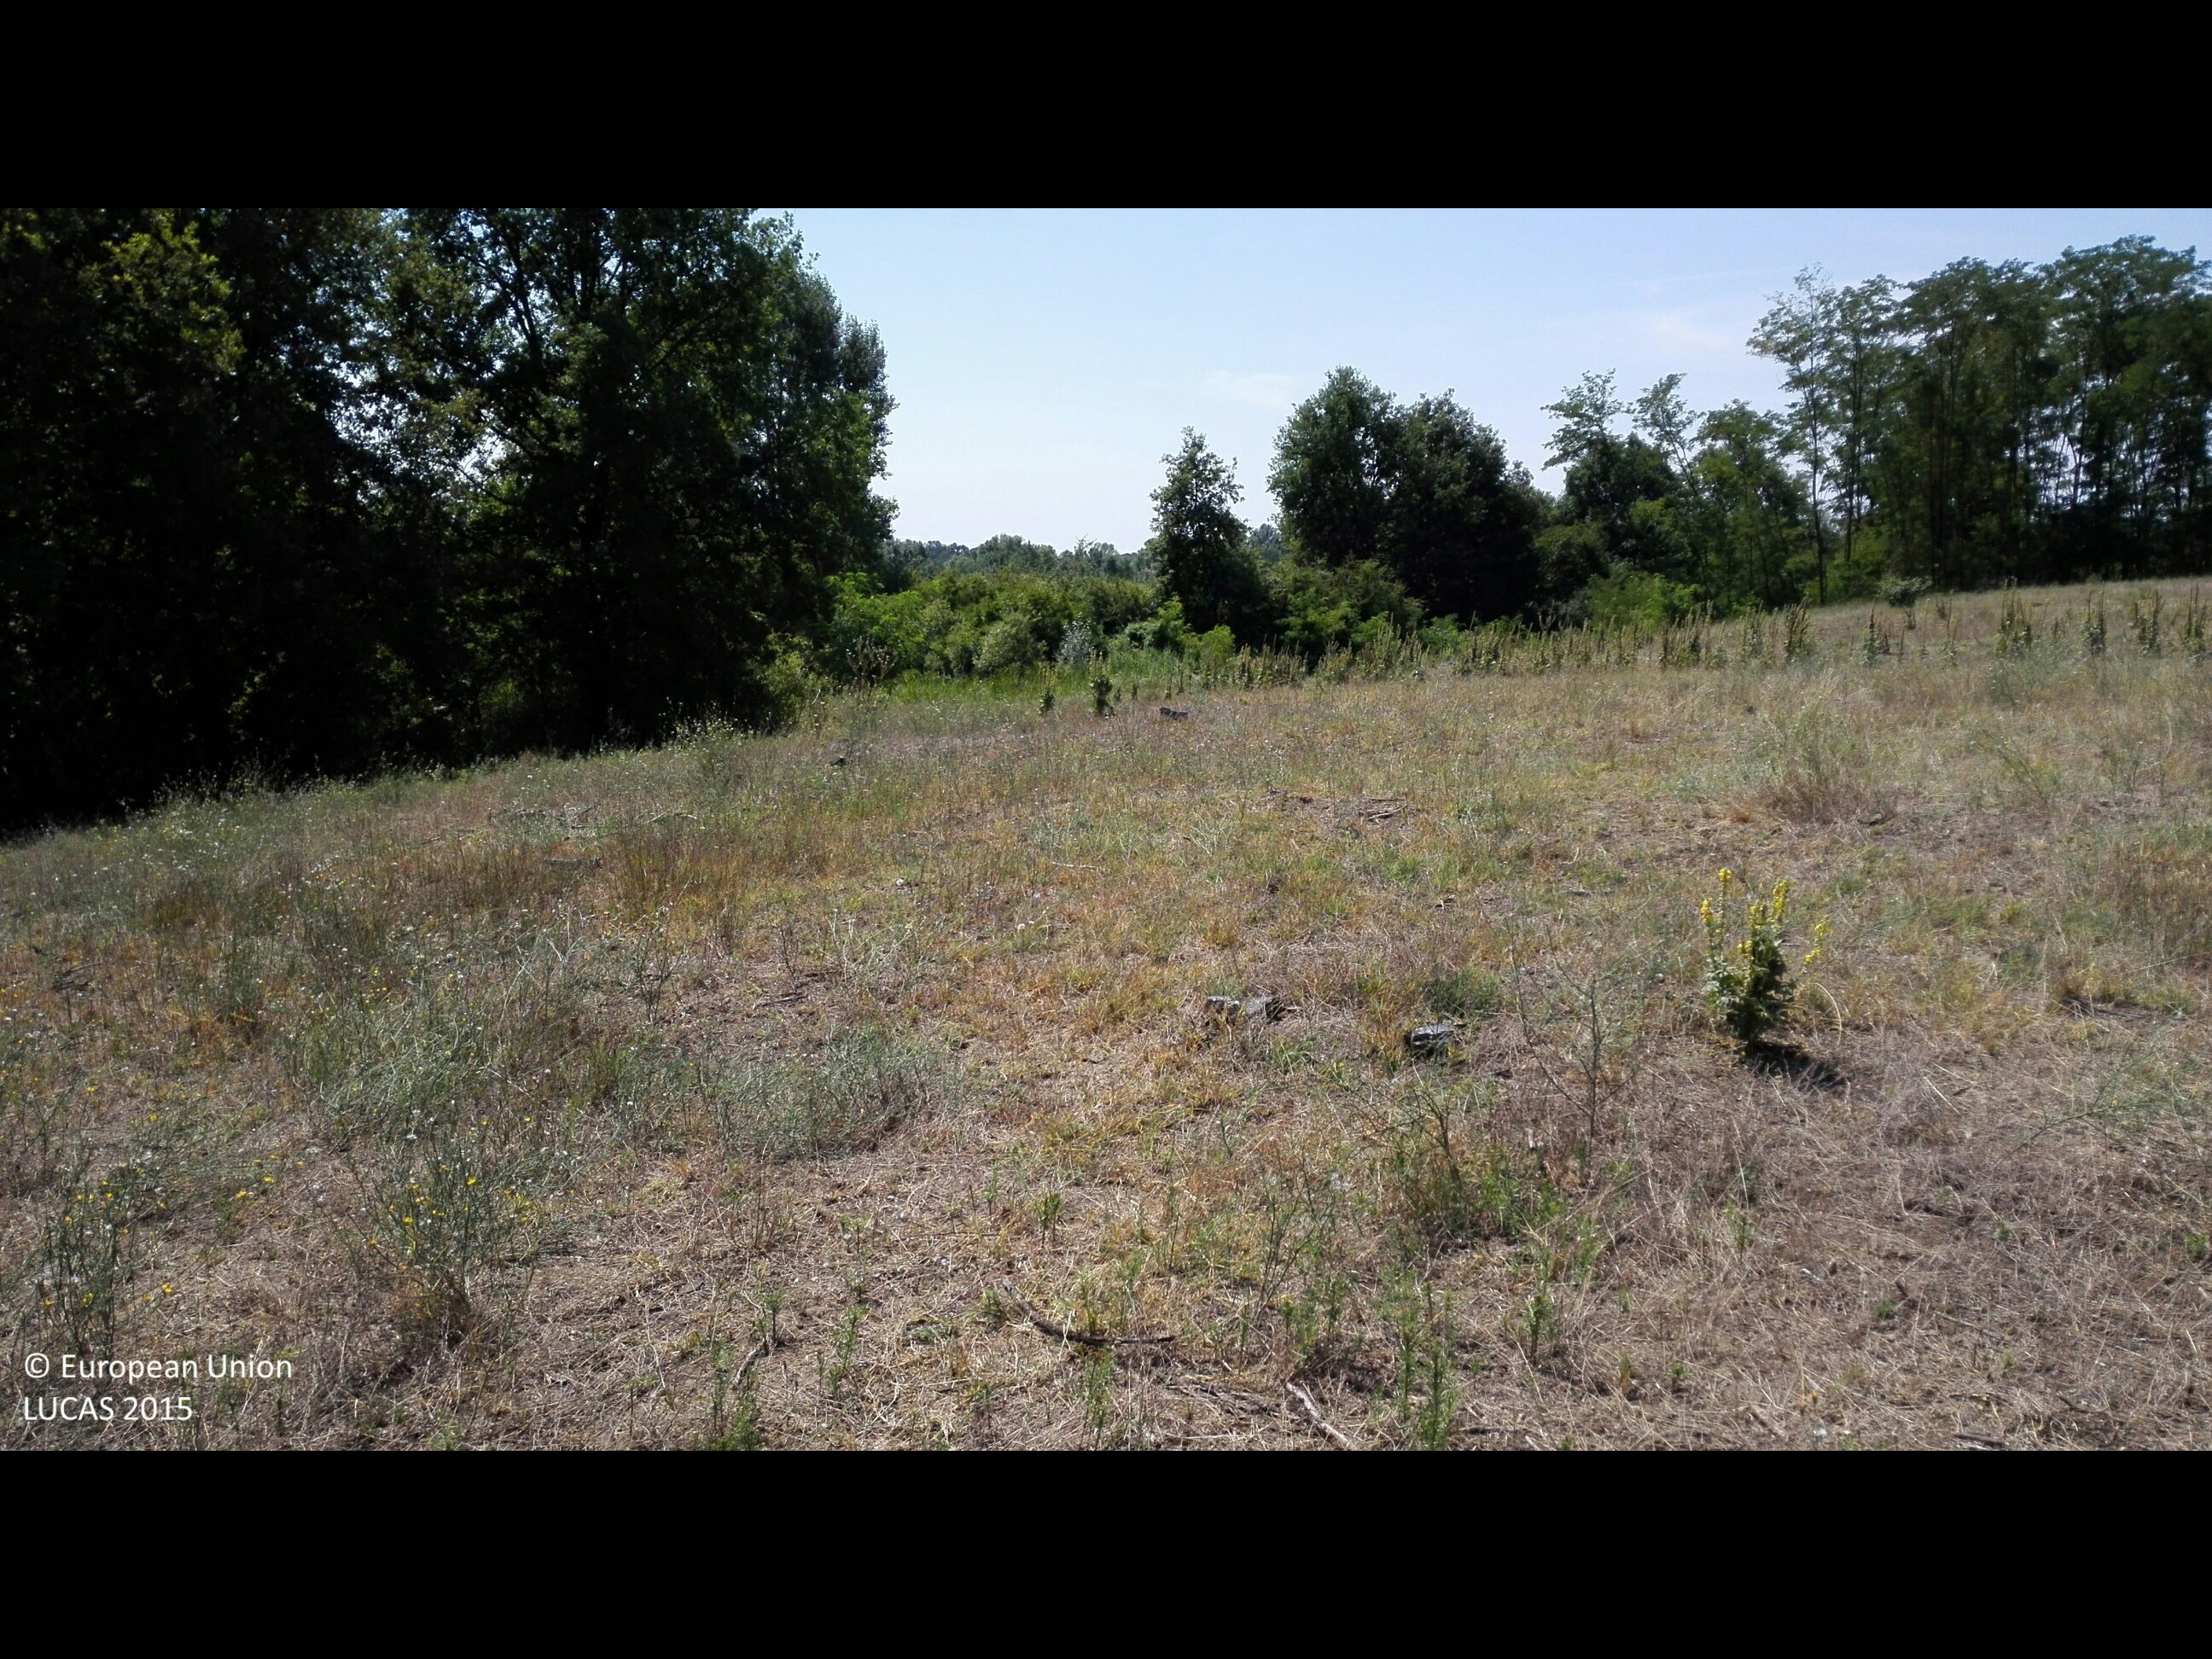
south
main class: Grassland
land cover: Grassland without tree/shrub cover
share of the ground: > 75 %
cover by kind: herbaceous plants 100 %
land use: Agriculture (excluding fallow land and kitchen gardens)
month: August
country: HU
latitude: 47.4351
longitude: 21.8610
